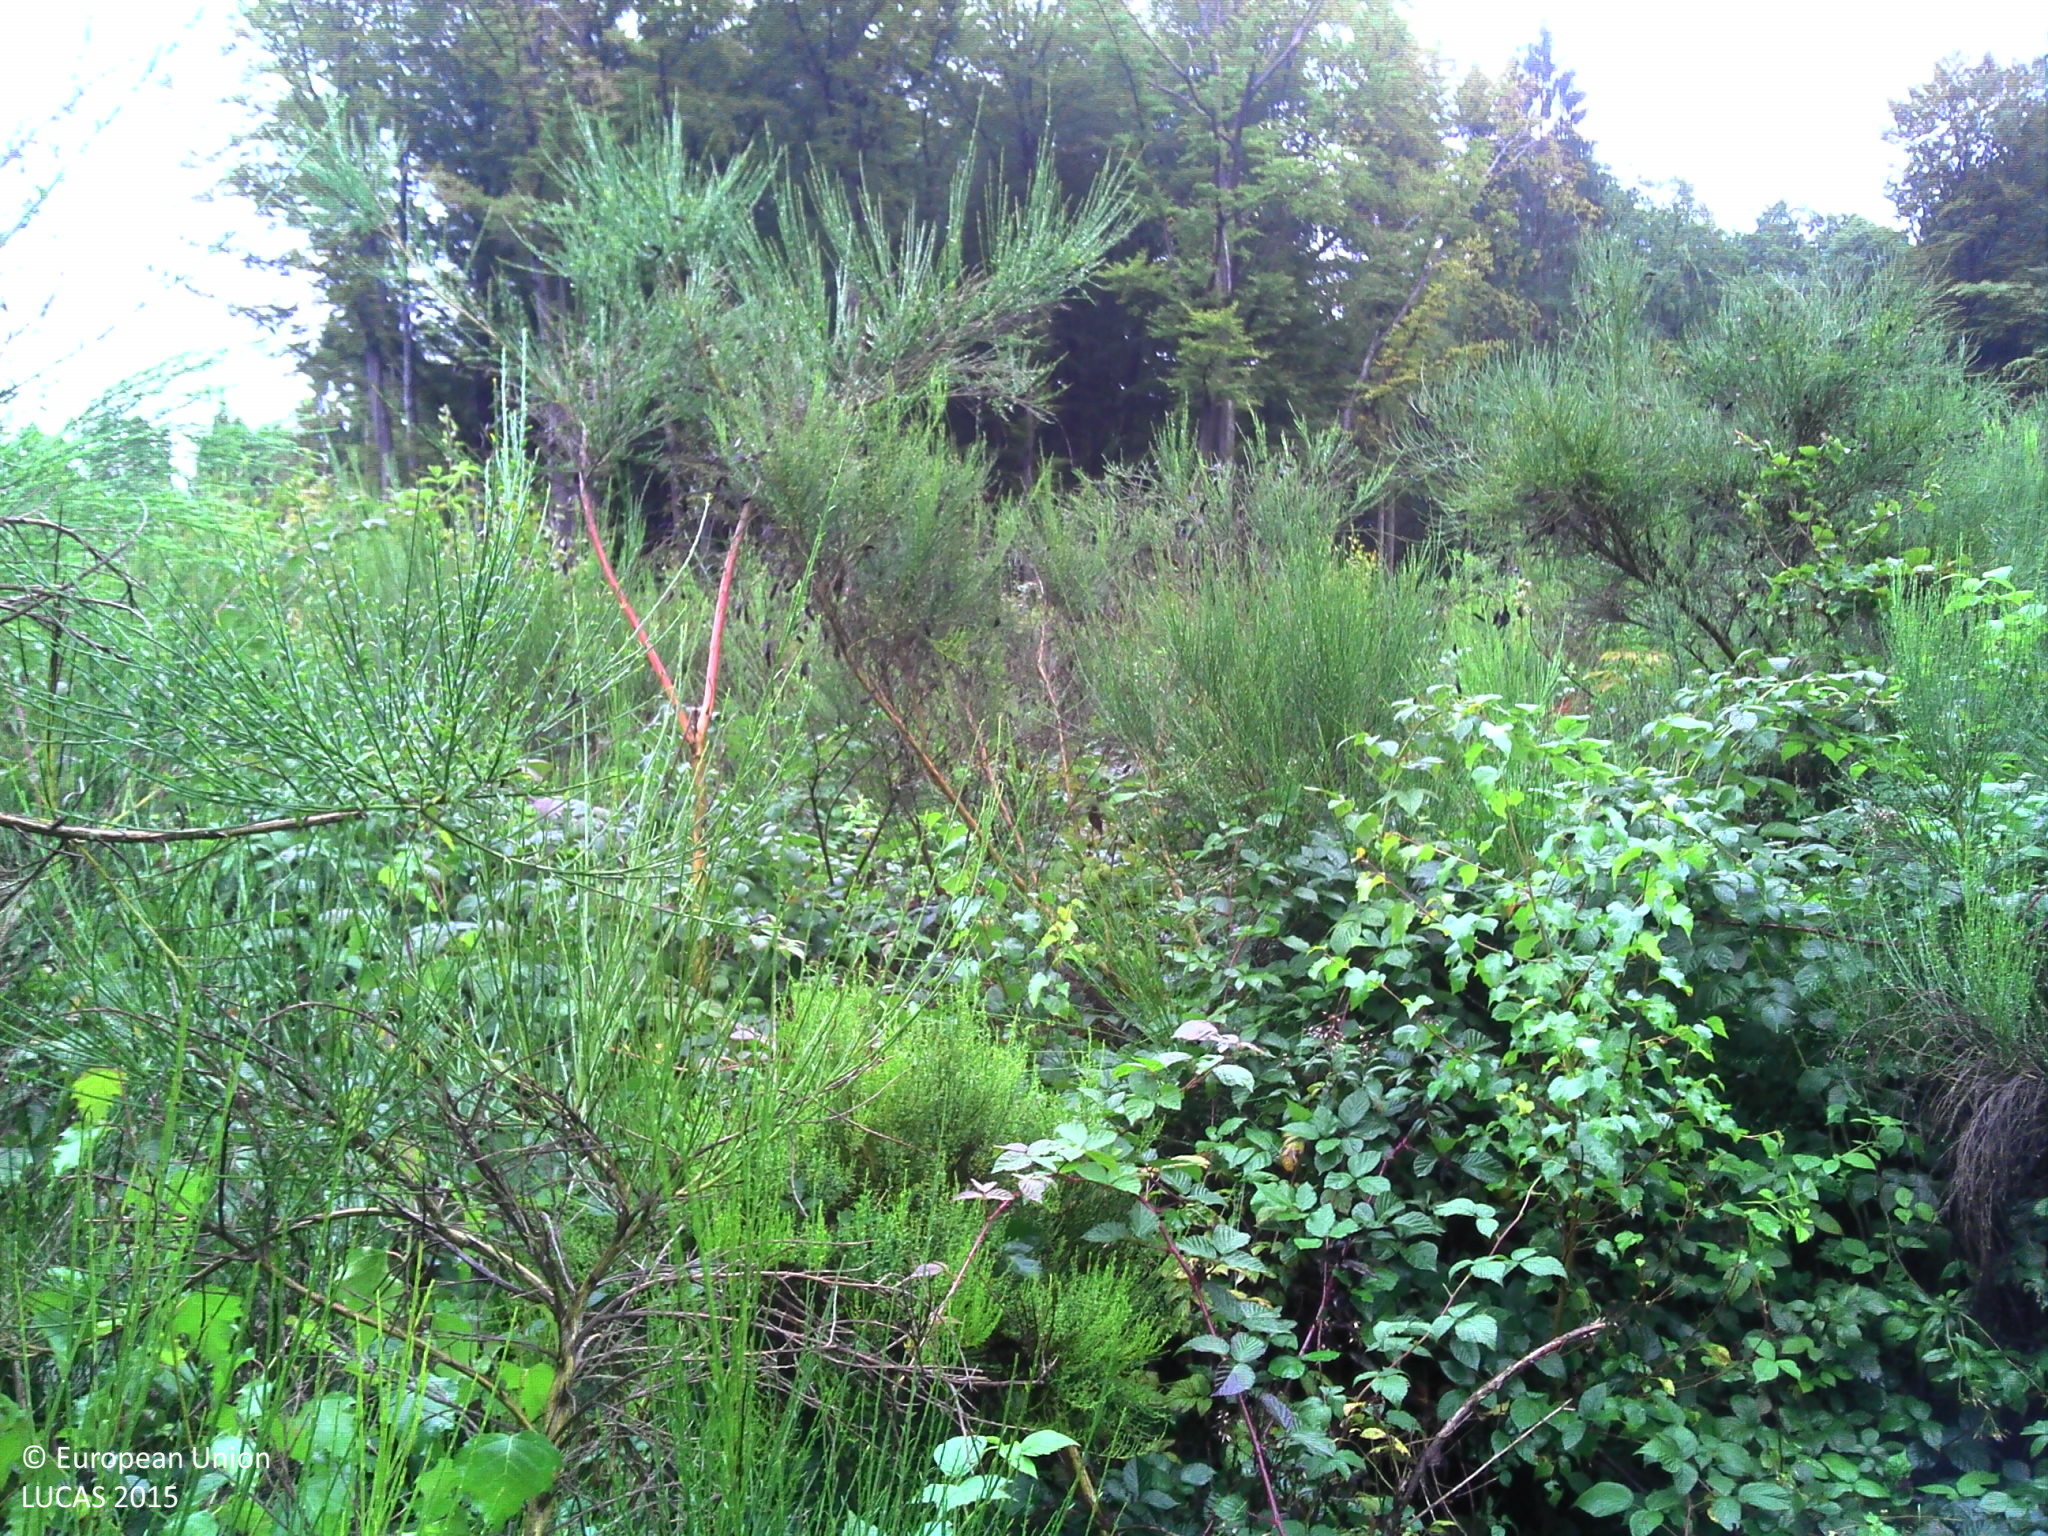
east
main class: Shrubland
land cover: Shrubland with sparse tree cover
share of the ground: > 75 %
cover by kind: shrubs 95 %, broadleaved forest trees 5 %
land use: Forestry
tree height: < 5 m
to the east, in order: Shrubland with sparse tree cover; Tracks; Shrubland with sparse tree cover; Shrubland without tree cover; Spruce dominated coniferous woodland; Other coniferous woodland; Spruce dominated coniferous woodland; Shrubland without tree cover
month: September
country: LU
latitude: 49.8045
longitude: 5.9001
